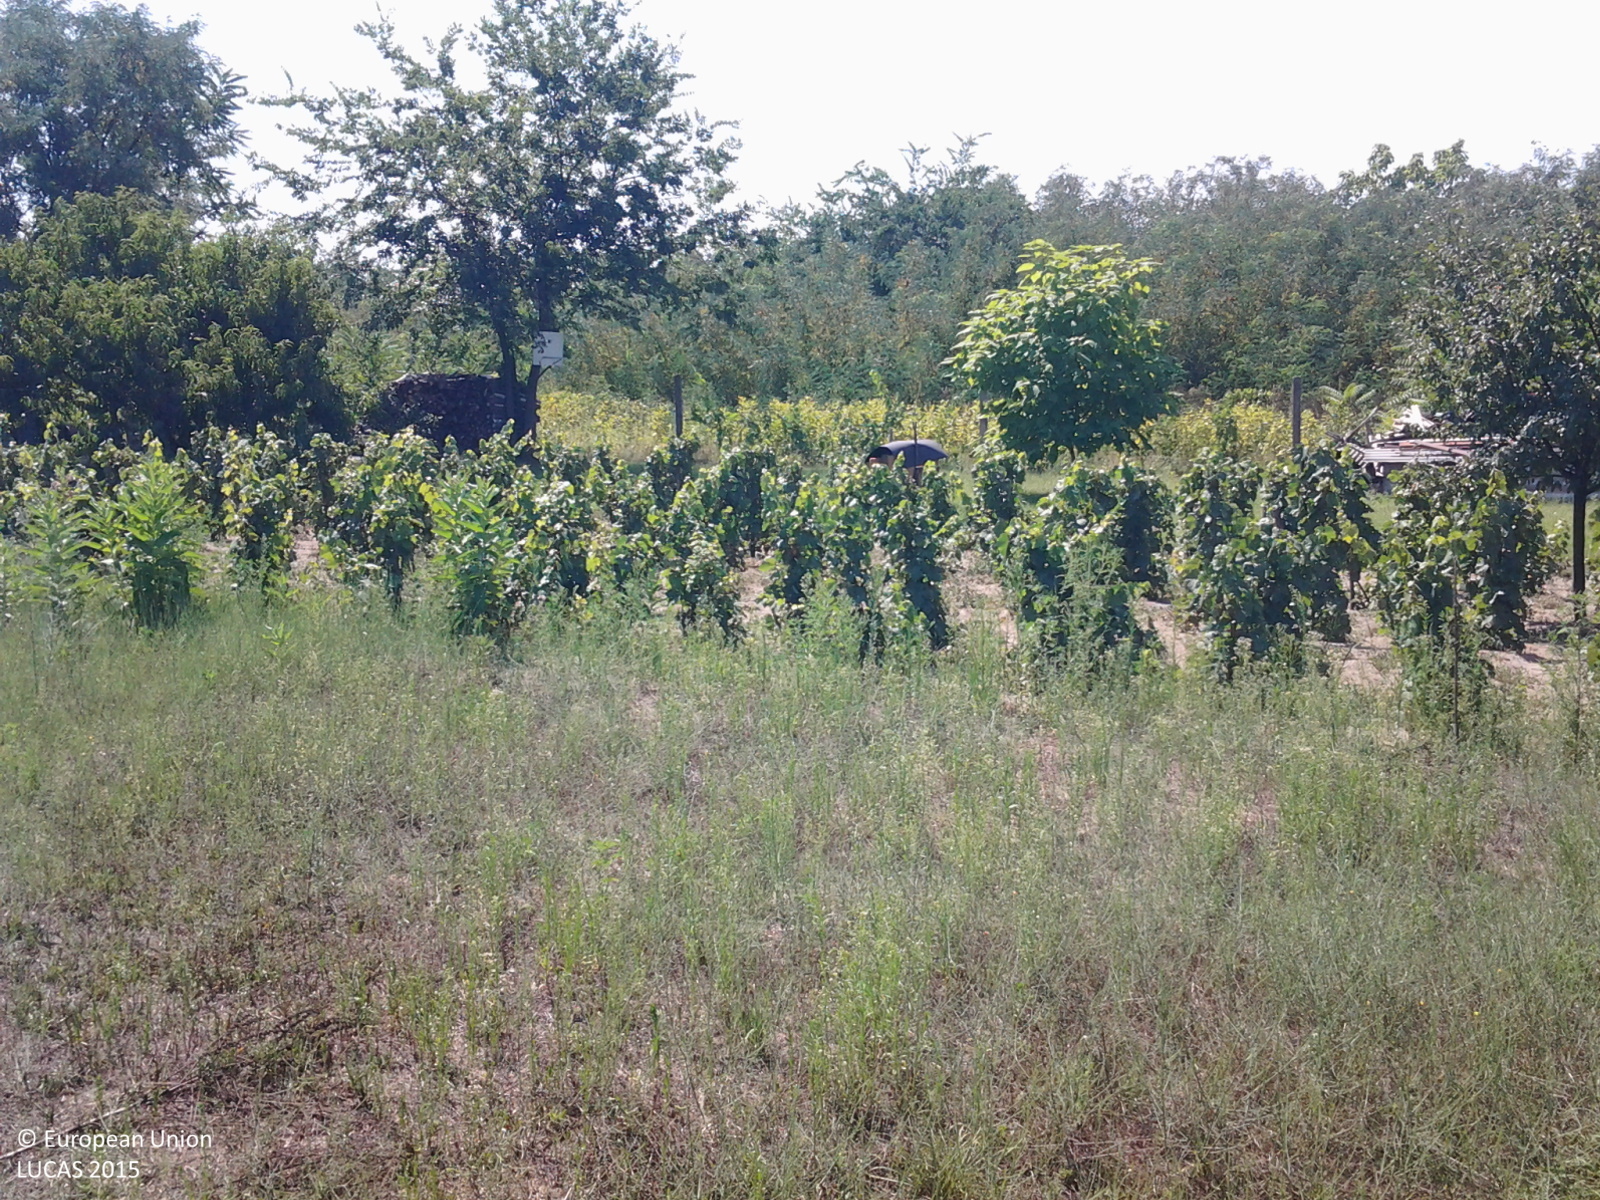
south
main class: Grassland
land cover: Spontaneously vegetated surfaces
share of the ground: > 75 %
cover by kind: herbaceous plants 100 %
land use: Fallow land
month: August
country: HU
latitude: 47.3349
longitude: 19.7766
